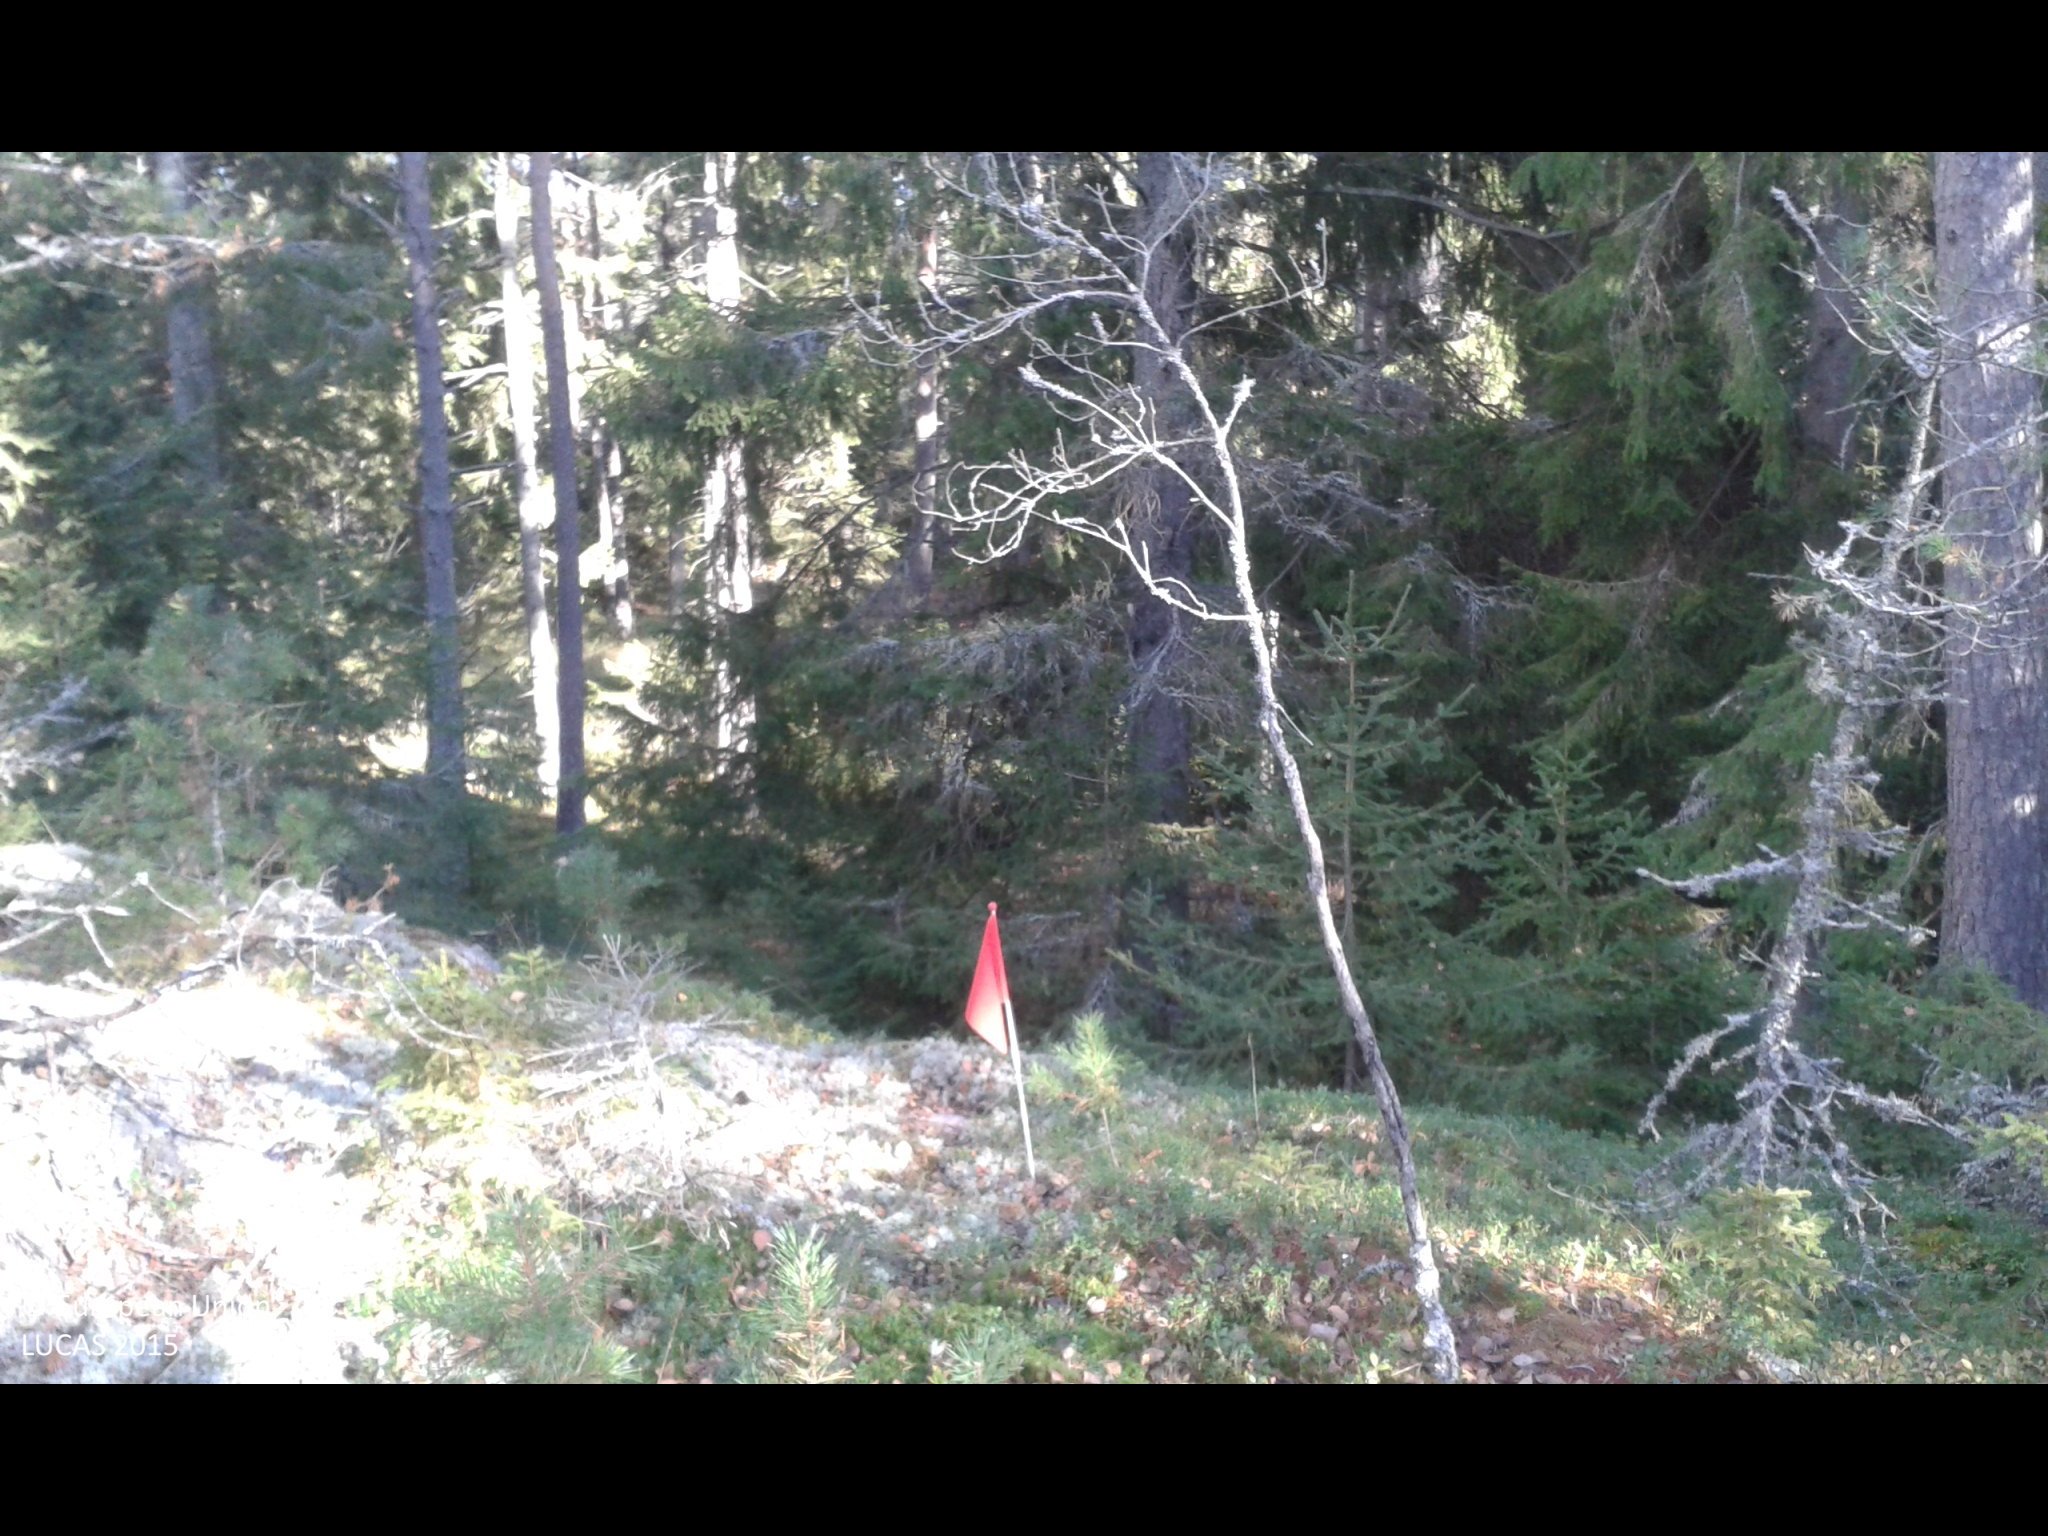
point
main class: Woodland
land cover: Other coniferous woodland
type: boreal forest
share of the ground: 25 - 50 %
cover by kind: herbaceous plants 40 %, coniferous forest trees 35 %, lichens and mosses 20 %, broadleaved forest trees 5 %
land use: Forestry
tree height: > 5 m
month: October
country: SE
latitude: 58.7990
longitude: 17.2836
